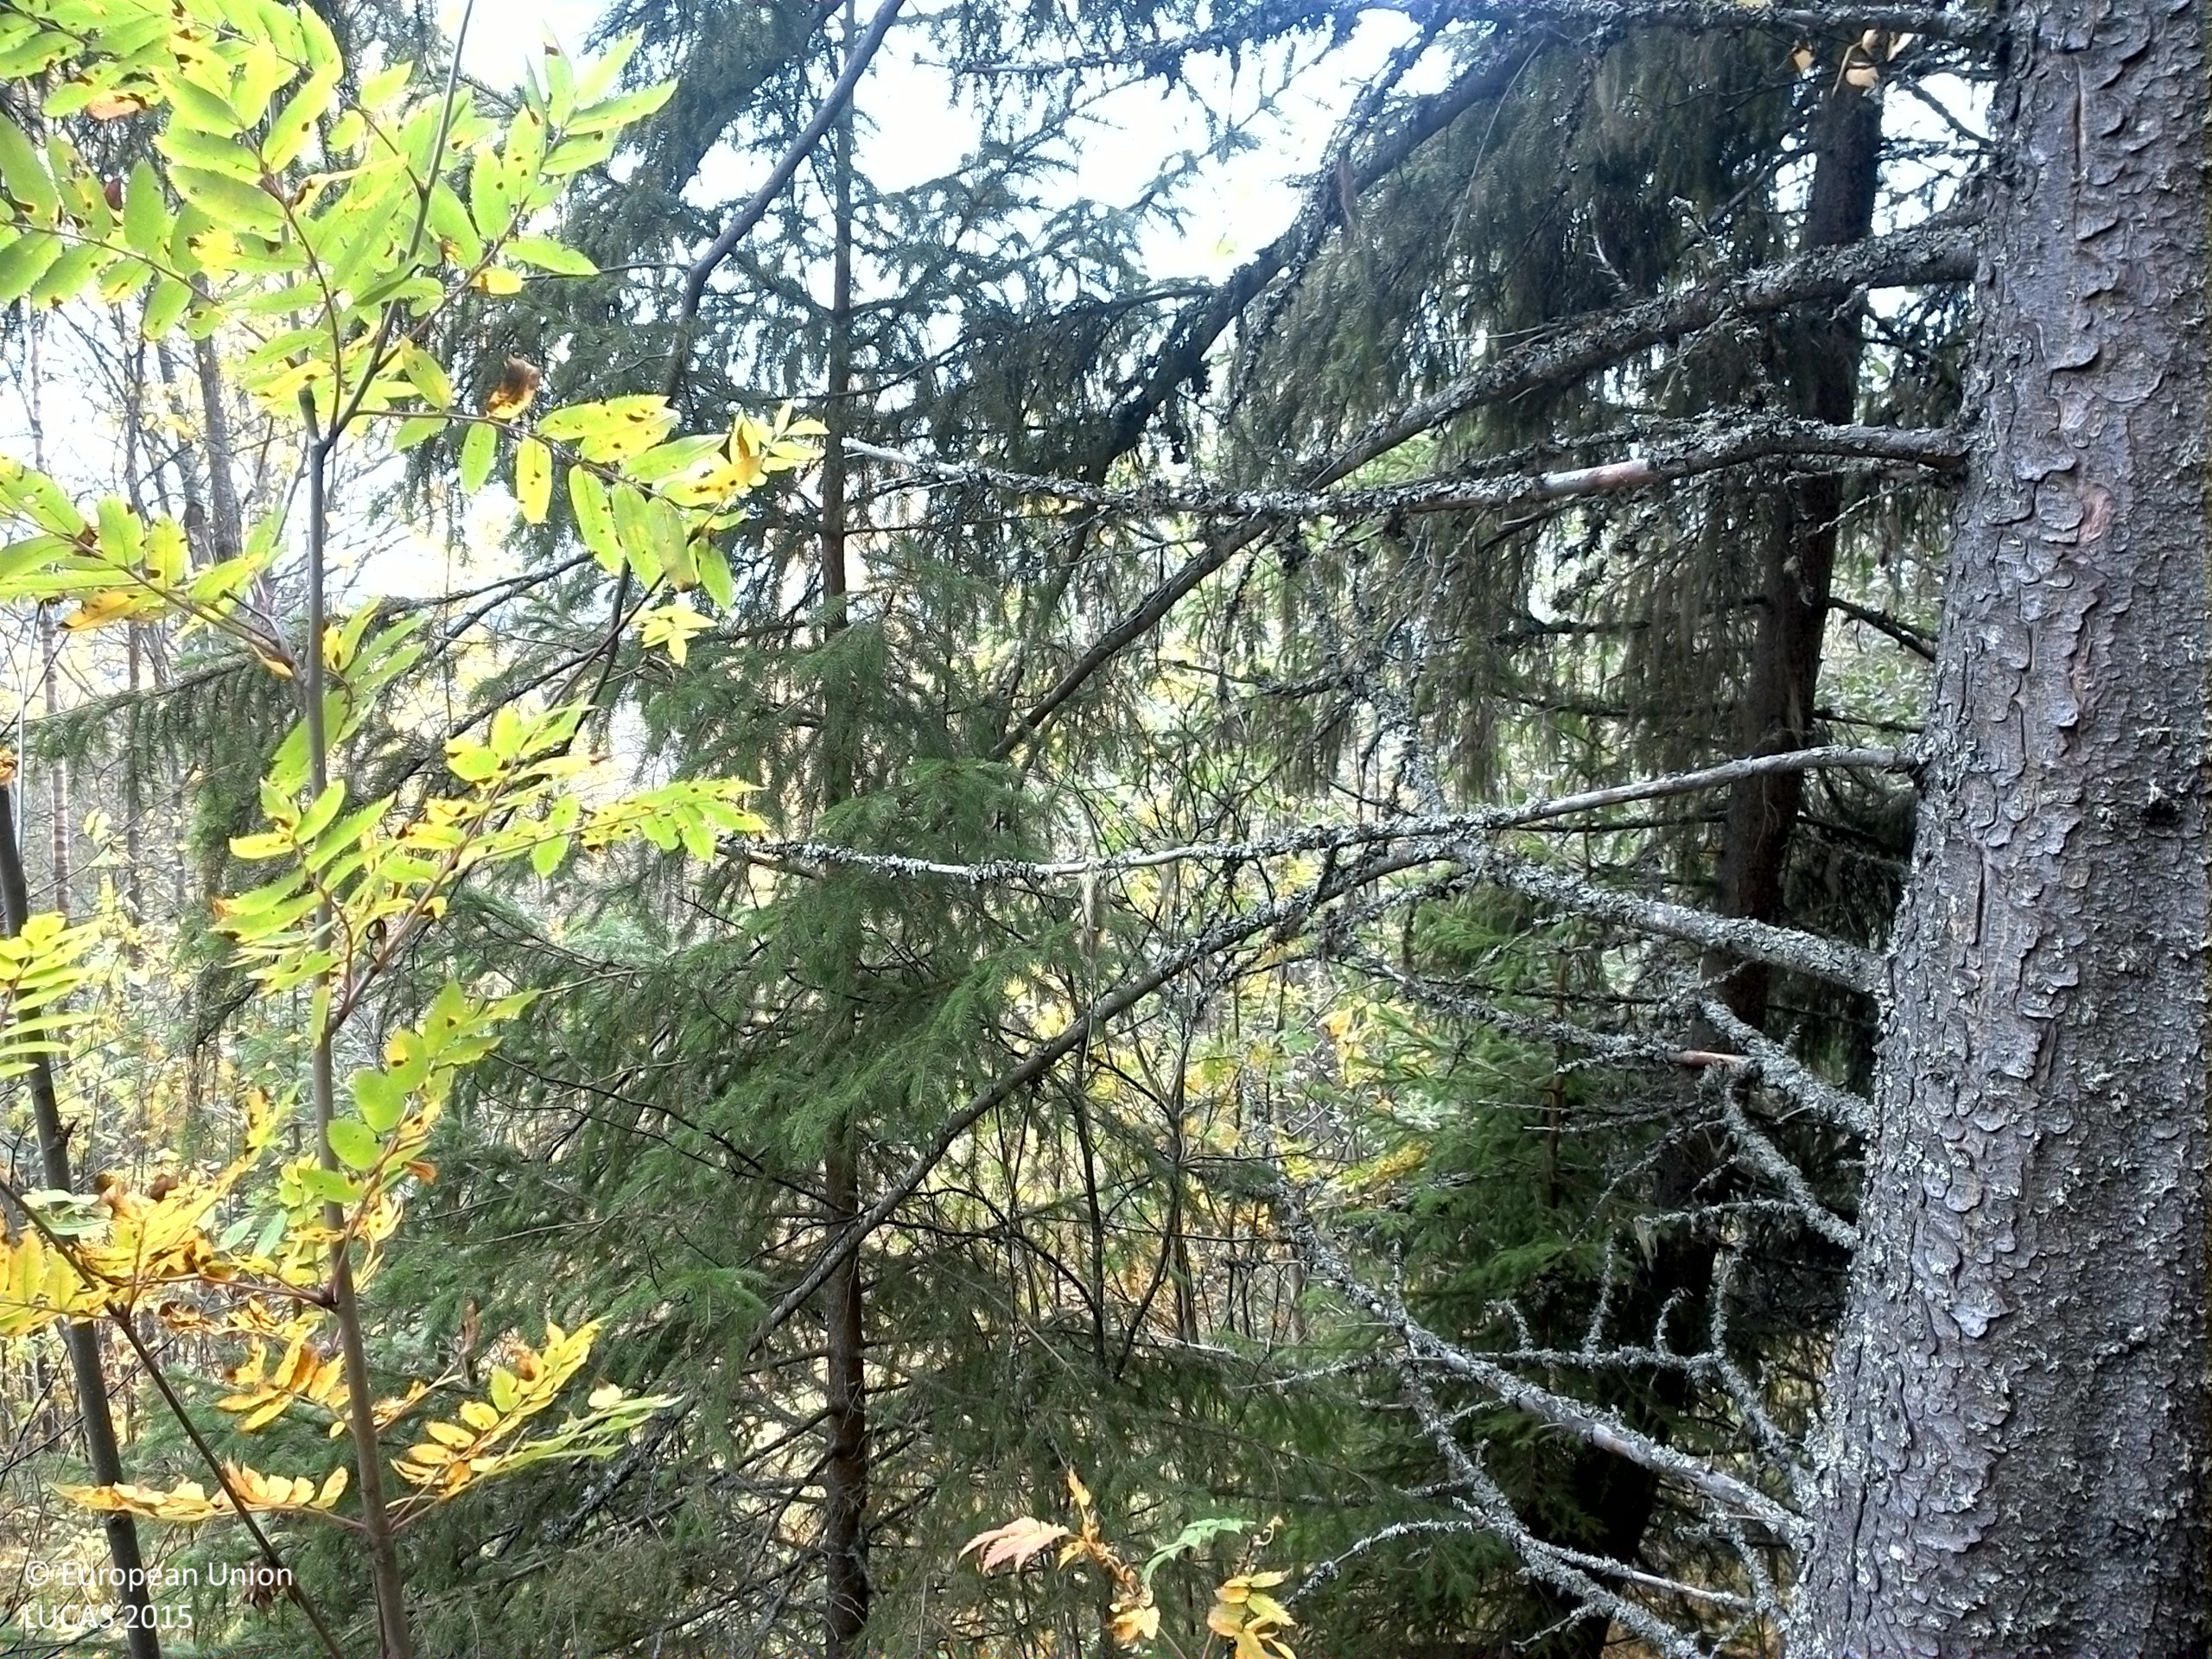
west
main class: Woodland
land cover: Spruce dominated mixed woodland
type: boreal forest
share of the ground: 50 - 75 %
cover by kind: coniferous forest trees 40 %, broadleaved forest trees 25 %, shrubs 20 %, lichens and mosses 10 %, herbaceous plants 5 %
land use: Forestry
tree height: > 5 m
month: October
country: SE
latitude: 64.2151
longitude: 15.9252
